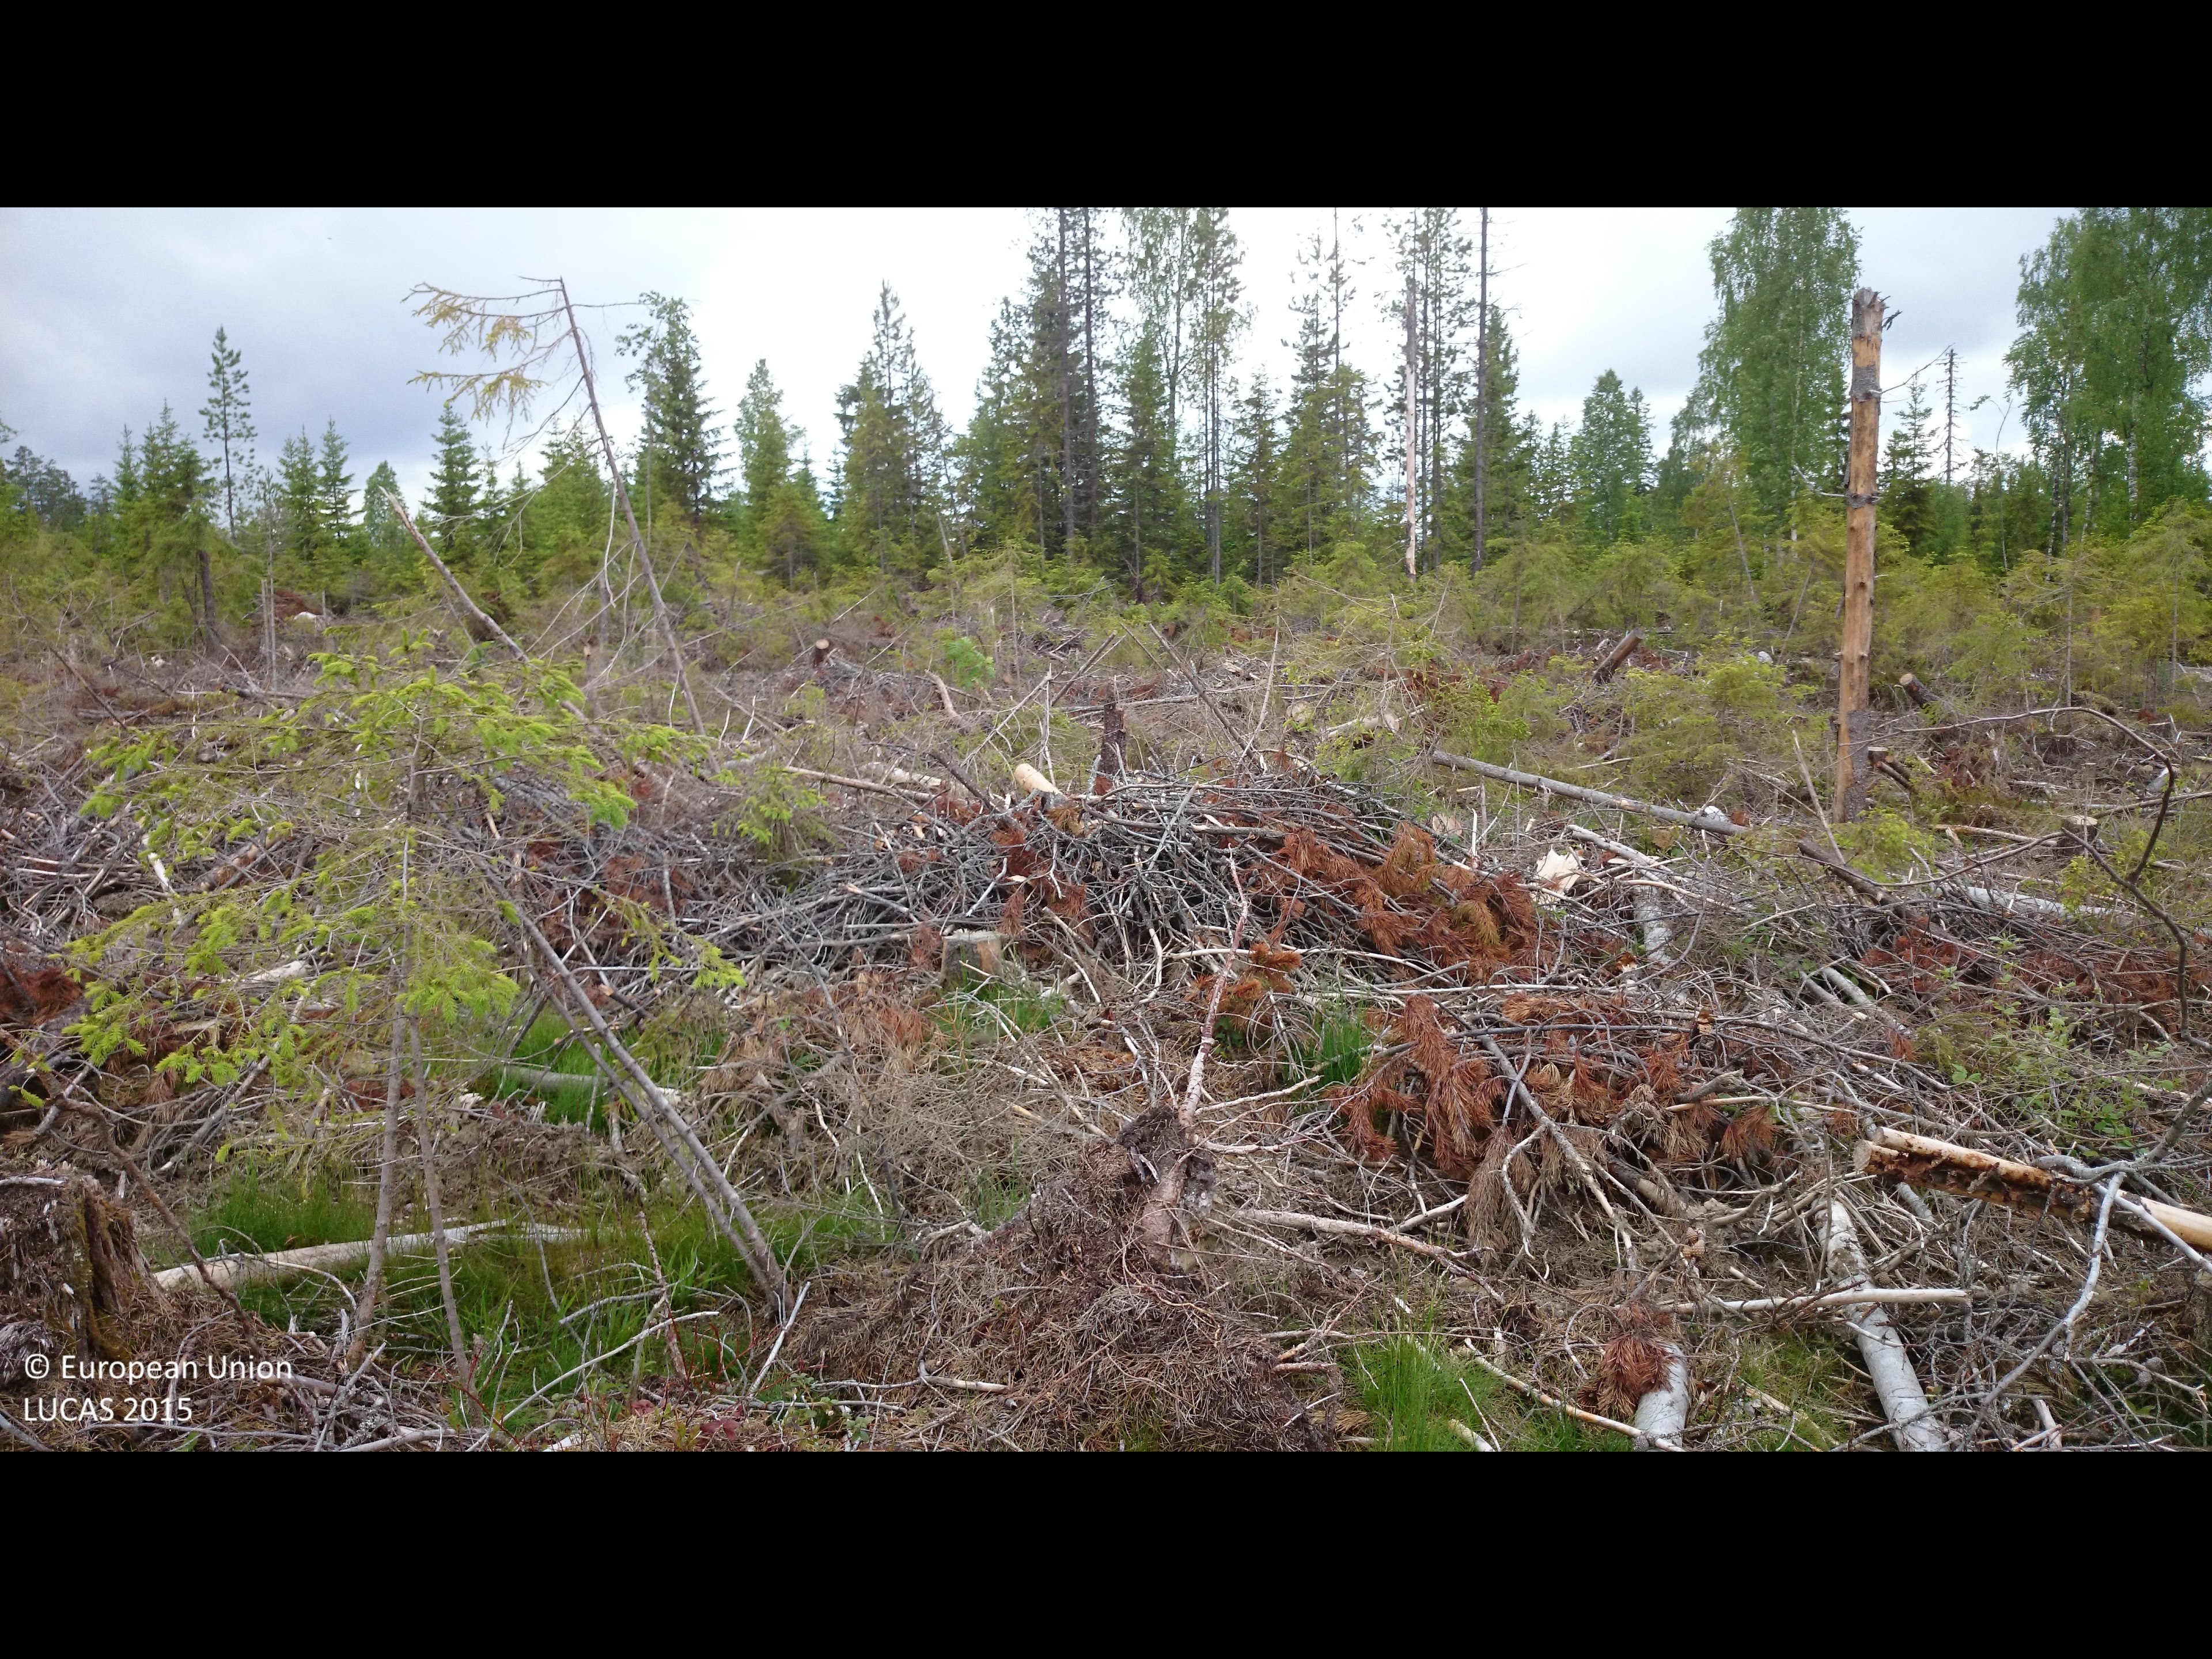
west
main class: Woodland
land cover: Spruce dominated coniferous woodland
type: boreal forest
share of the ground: 10 - 25 %
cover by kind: coniferous forest trees 30 %
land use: Forestry
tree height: < 5 m
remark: Clear cut
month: June
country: SE
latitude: 62.0761
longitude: 16.8534
